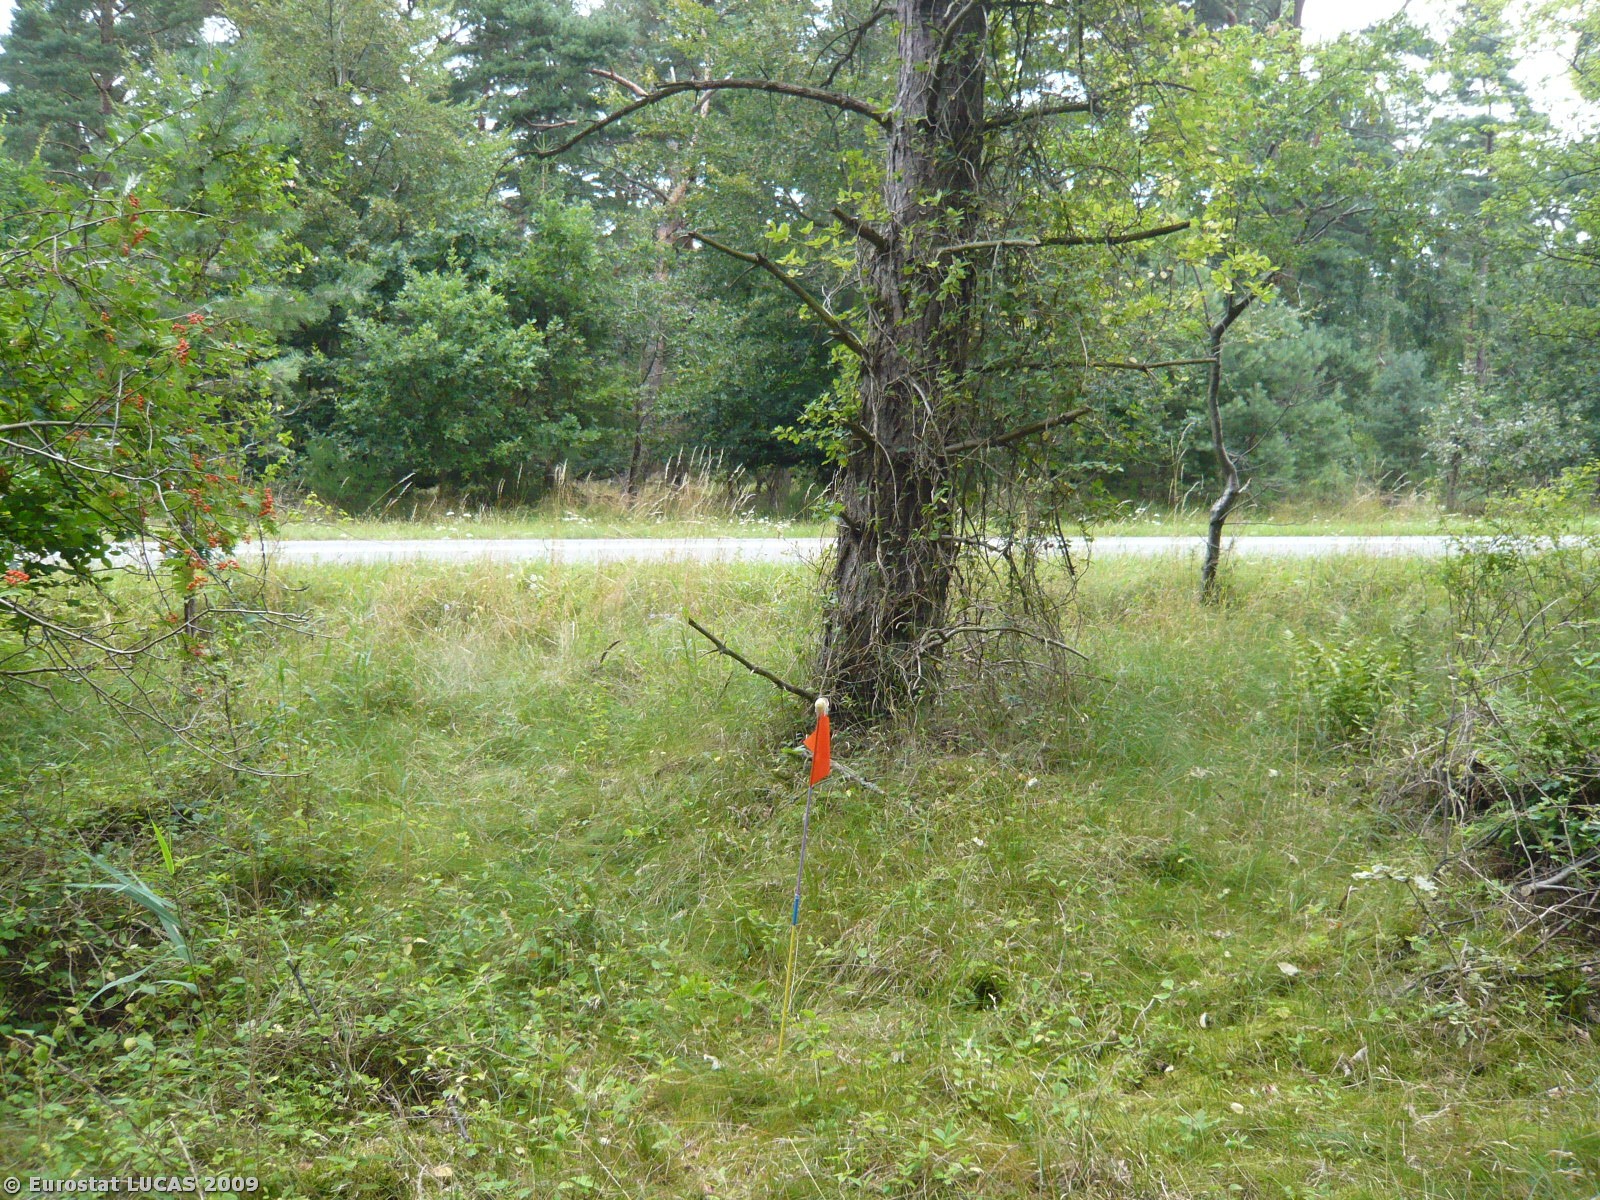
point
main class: Woodland
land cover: Coniferous woodland
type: hemiboreal forest and nemoral coniferous forest and mixed broadleaved-coniferous forest
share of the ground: > 75 %
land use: Residential
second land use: Amenities, museums, leisure
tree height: > 5 m
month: August
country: DK
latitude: 56.0103
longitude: 12.0029
